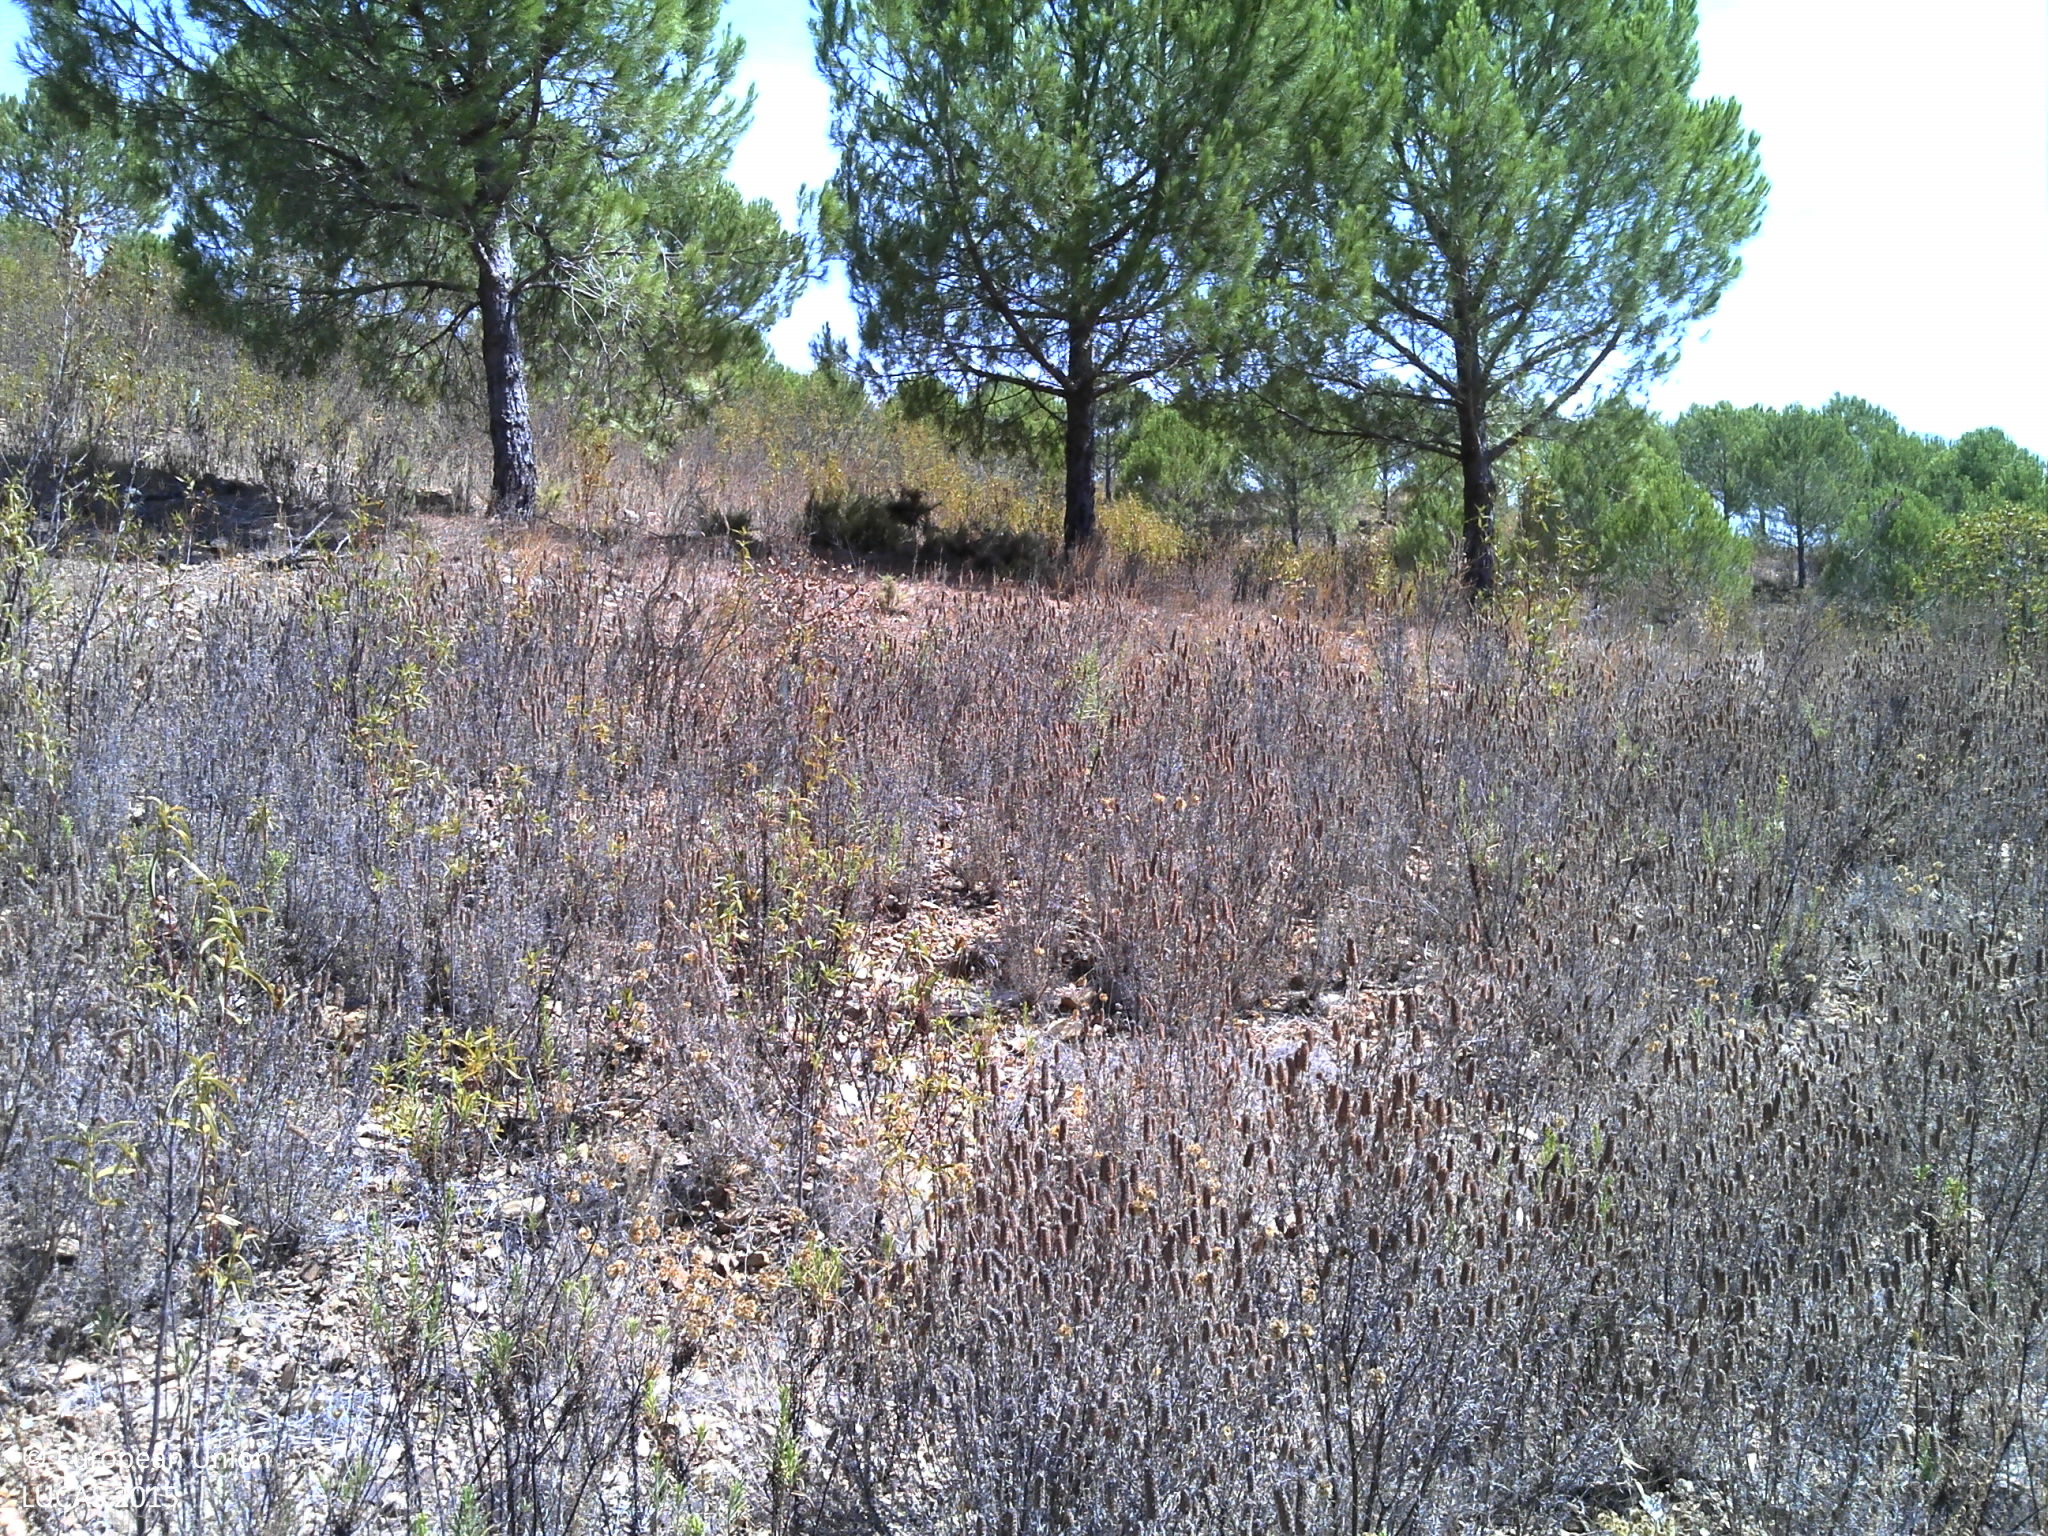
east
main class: Grassland
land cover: Grassland with sparse tree/shrub cover
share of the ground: 50 - 75 %
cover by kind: herbaceous plants 60 %, unconsolidated bare surface 35 %, broadleaved forest trees 5 %
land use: Forestry
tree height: < 5 m
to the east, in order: Grassland with sparse tree/shrub cover; Pine dominated coniferous woodland; Other structural elements; Pine dominated coniferous woodland; Grassland with sparse tree/shrub cover; Shrubland without tree cover; Rivers and streams
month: September
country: PT
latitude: 37.3664
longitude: -8.1899
